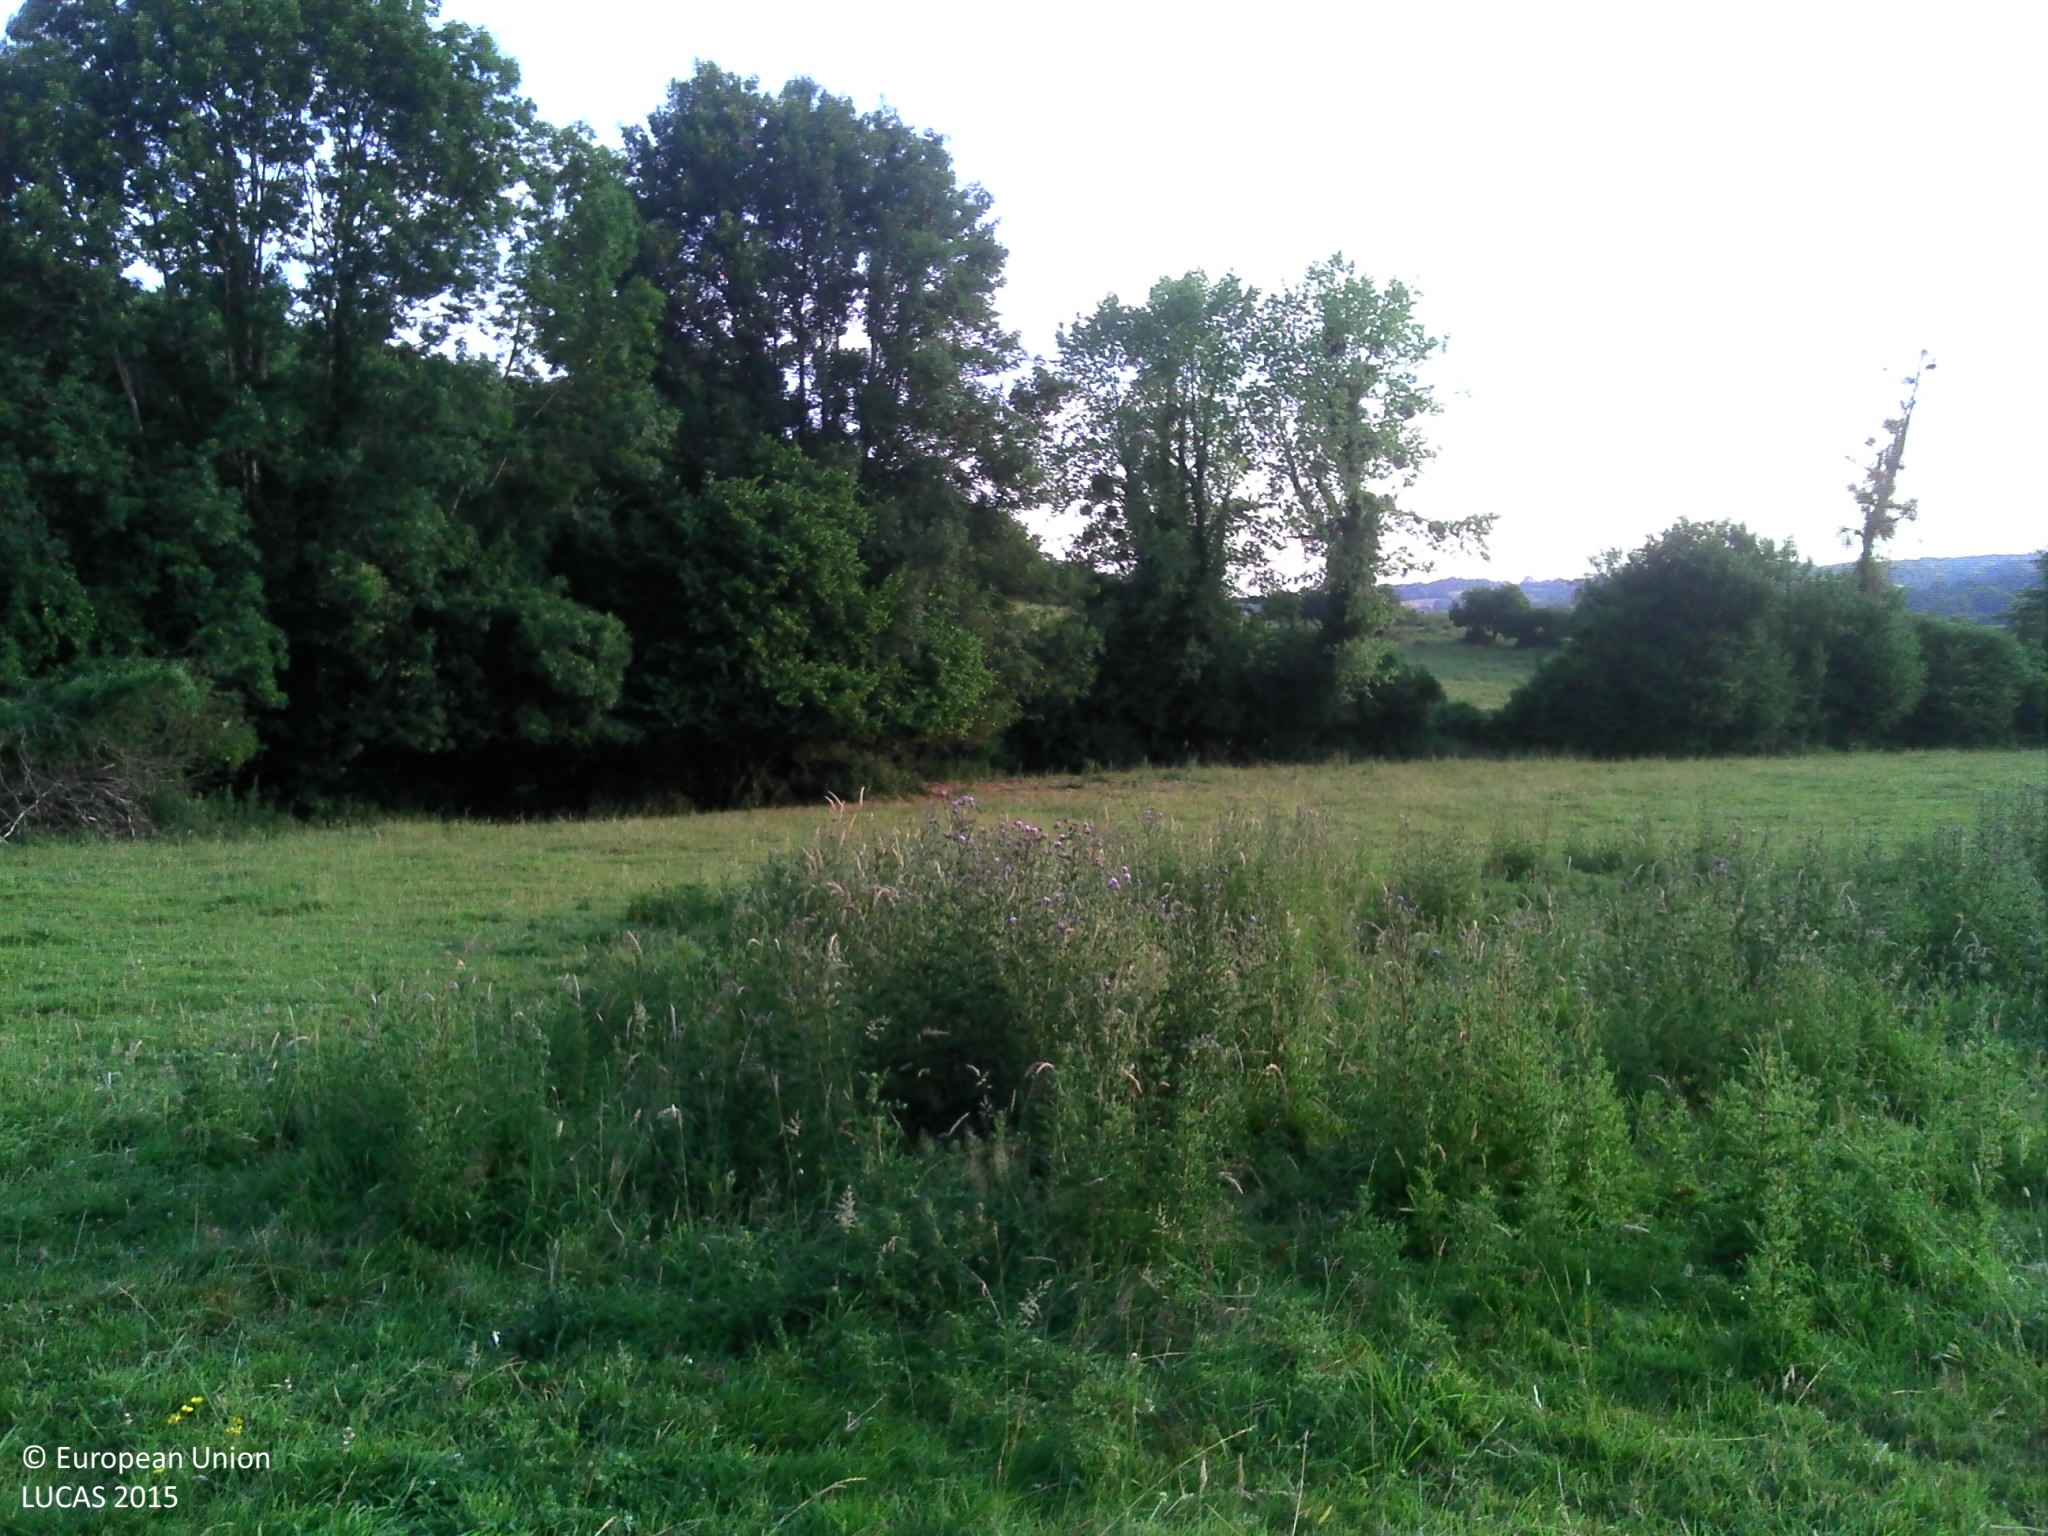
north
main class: Grassland
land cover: Grassland without tree/shrub cover
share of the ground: > 75 %
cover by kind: herbaceous plants 100 %
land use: Agriculture (excluding fallow land and kitchen gardens)
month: July
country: FR
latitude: 49.0308
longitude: 0.1366
